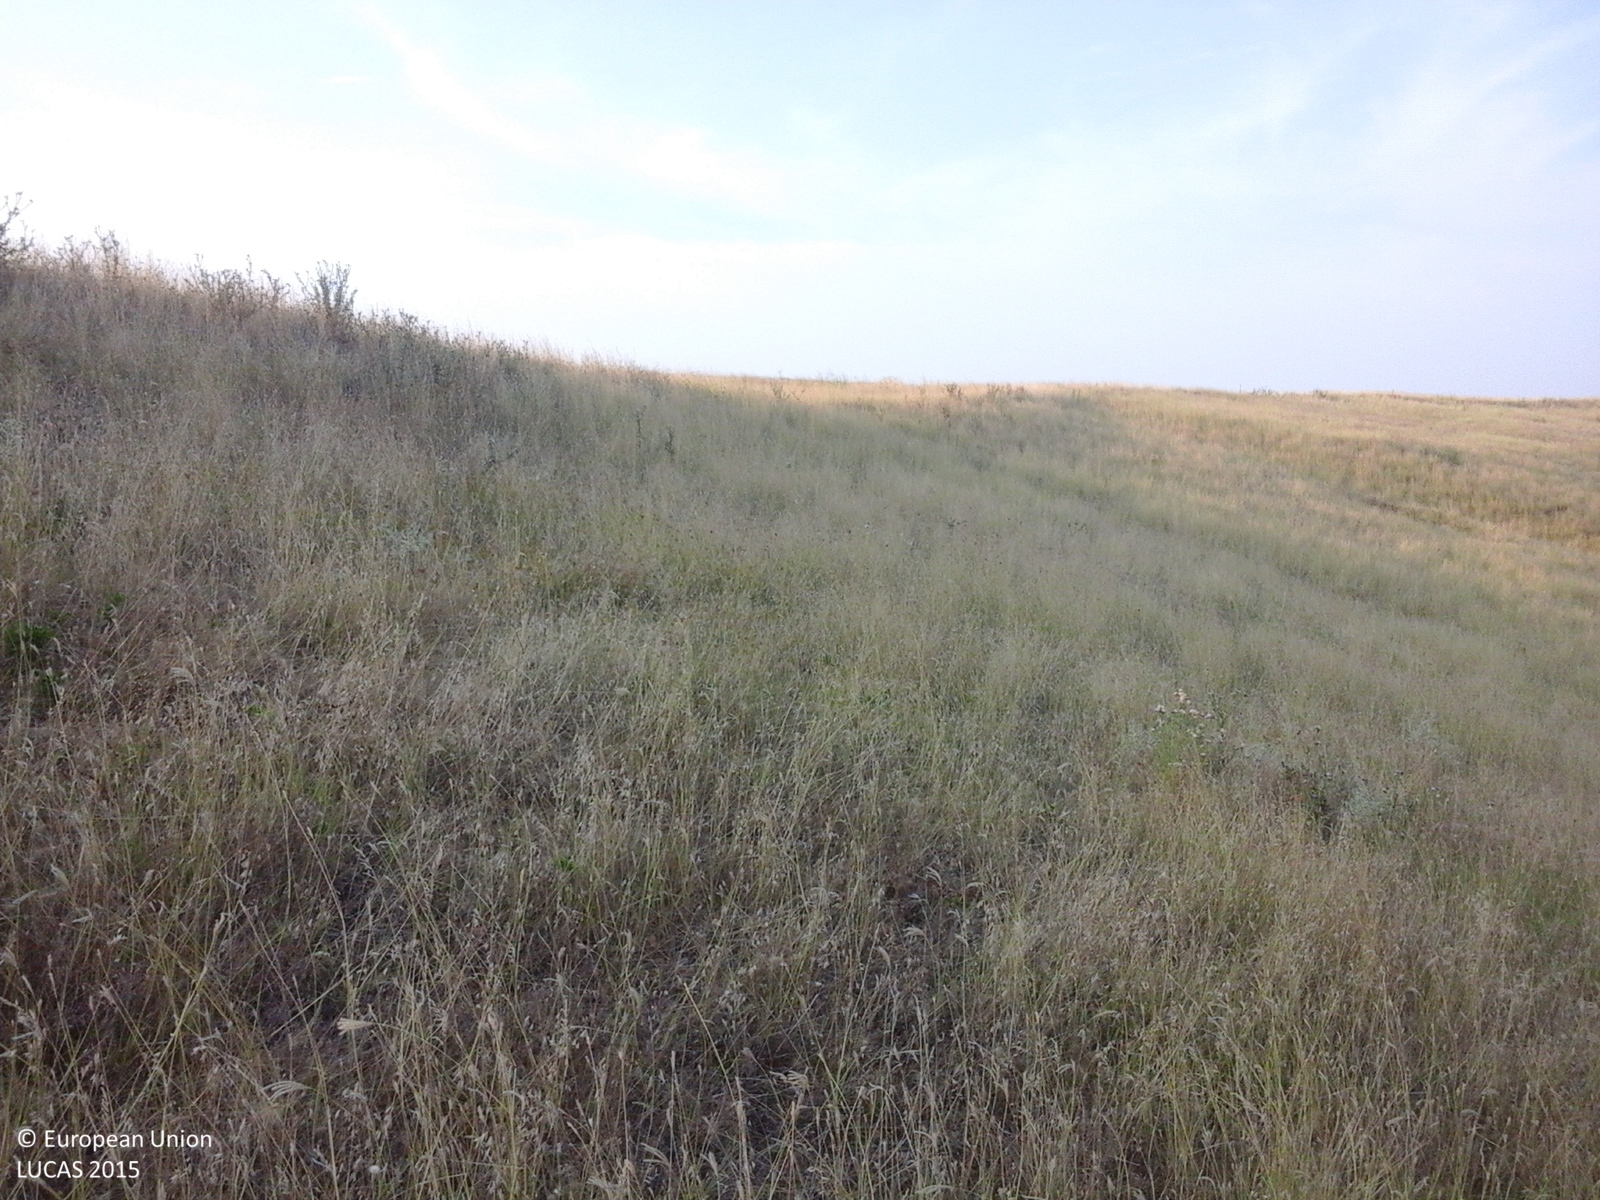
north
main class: Grassland
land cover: Grassland without tree/shrub cover
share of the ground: > 75 %
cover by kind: herbaceous plants 100 %
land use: Agriculture (excluding fallow land and kitchen gardens)
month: August
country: RO
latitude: 44.2662
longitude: 23.0855
